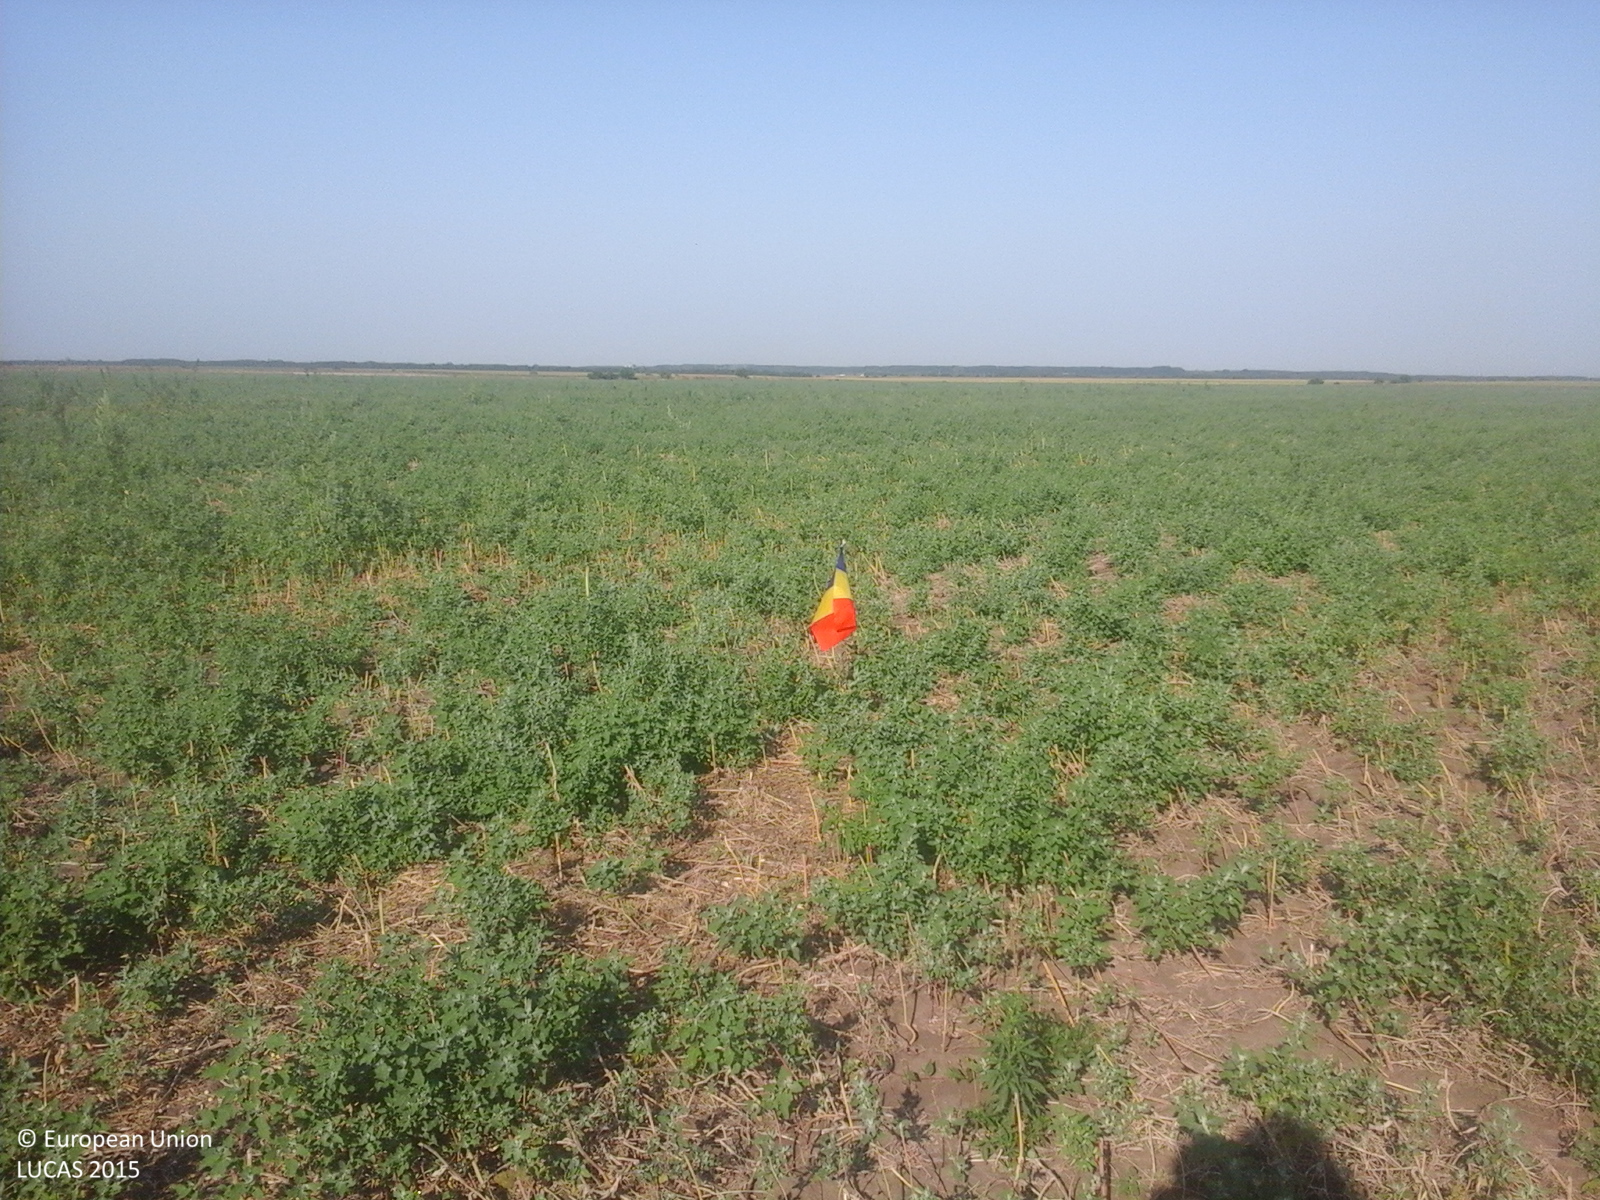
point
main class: Grassland
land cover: Spontaneously vegetated surfaces
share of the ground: > 75 %
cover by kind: herbaceous plants 80 %, unconsolidated bare surface 20 %
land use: Fallow land
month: July
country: RO
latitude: 44.3716
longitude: 27.2132
